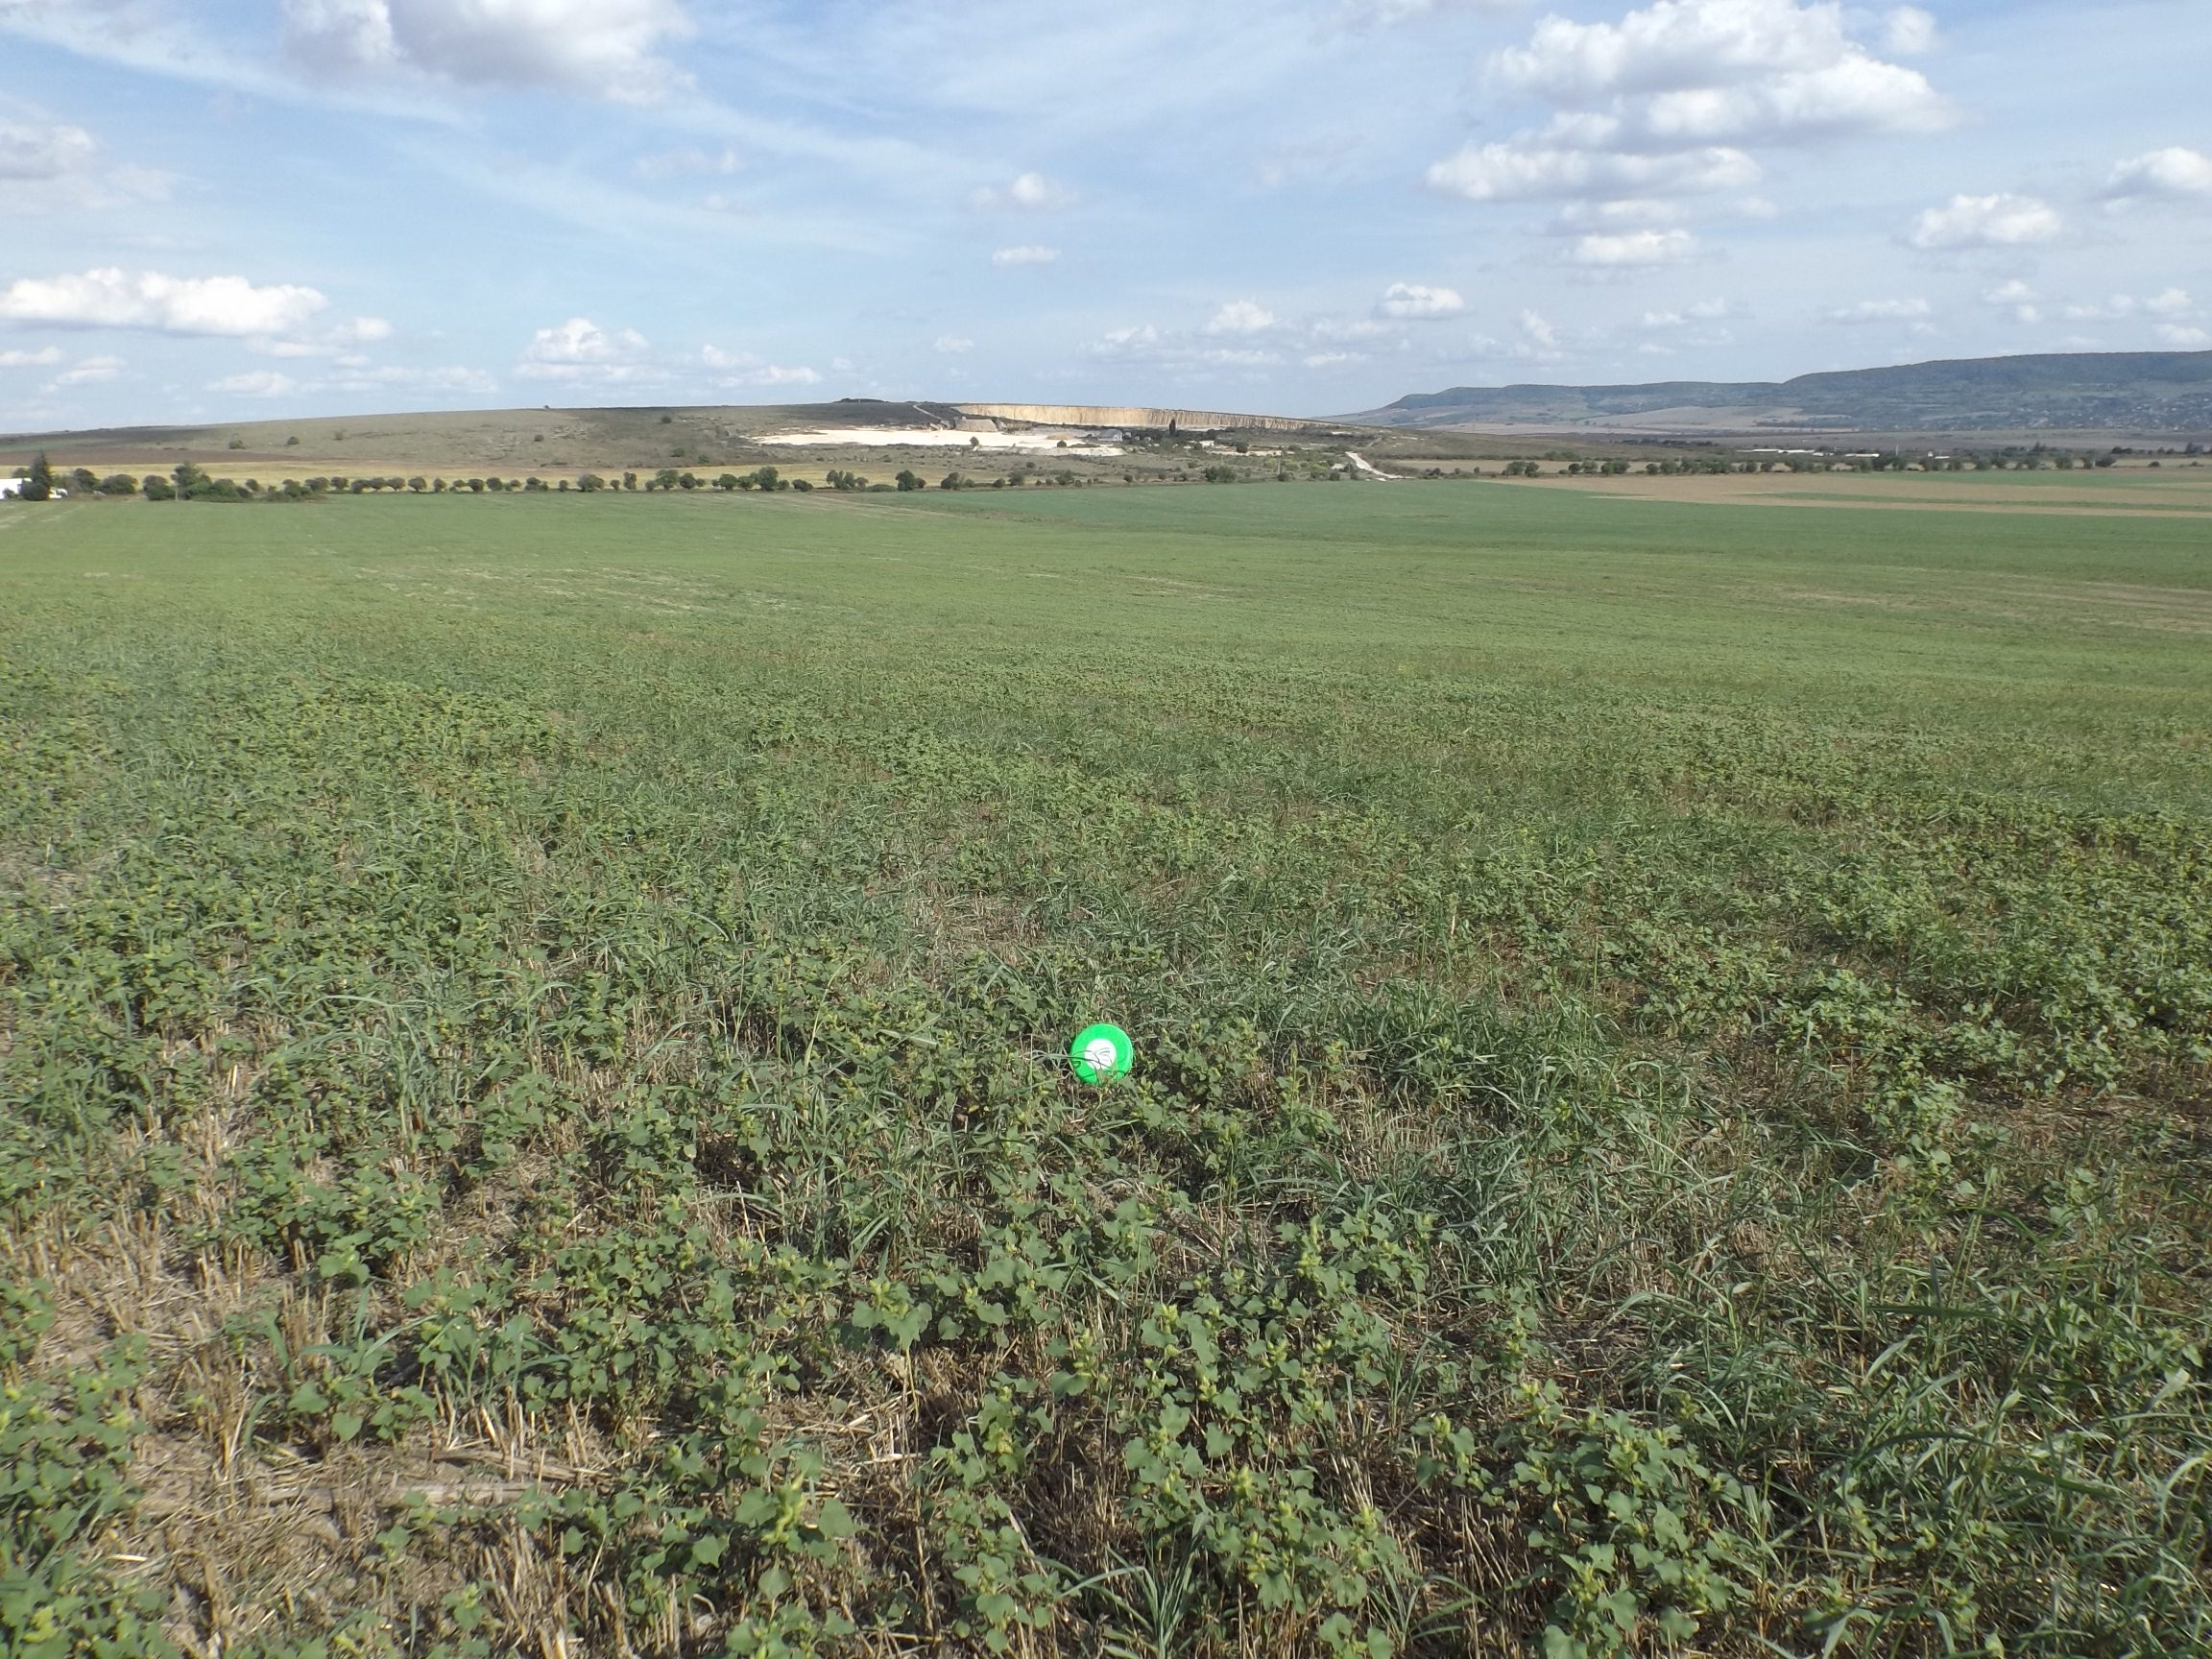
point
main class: Cropland
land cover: Common wheat
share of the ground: < 10 %
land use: Agriculture (excluding fallow land and kitchen gardens)
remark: Harvested field
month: September
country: BG
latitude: 43.2698
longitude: 27.4117
